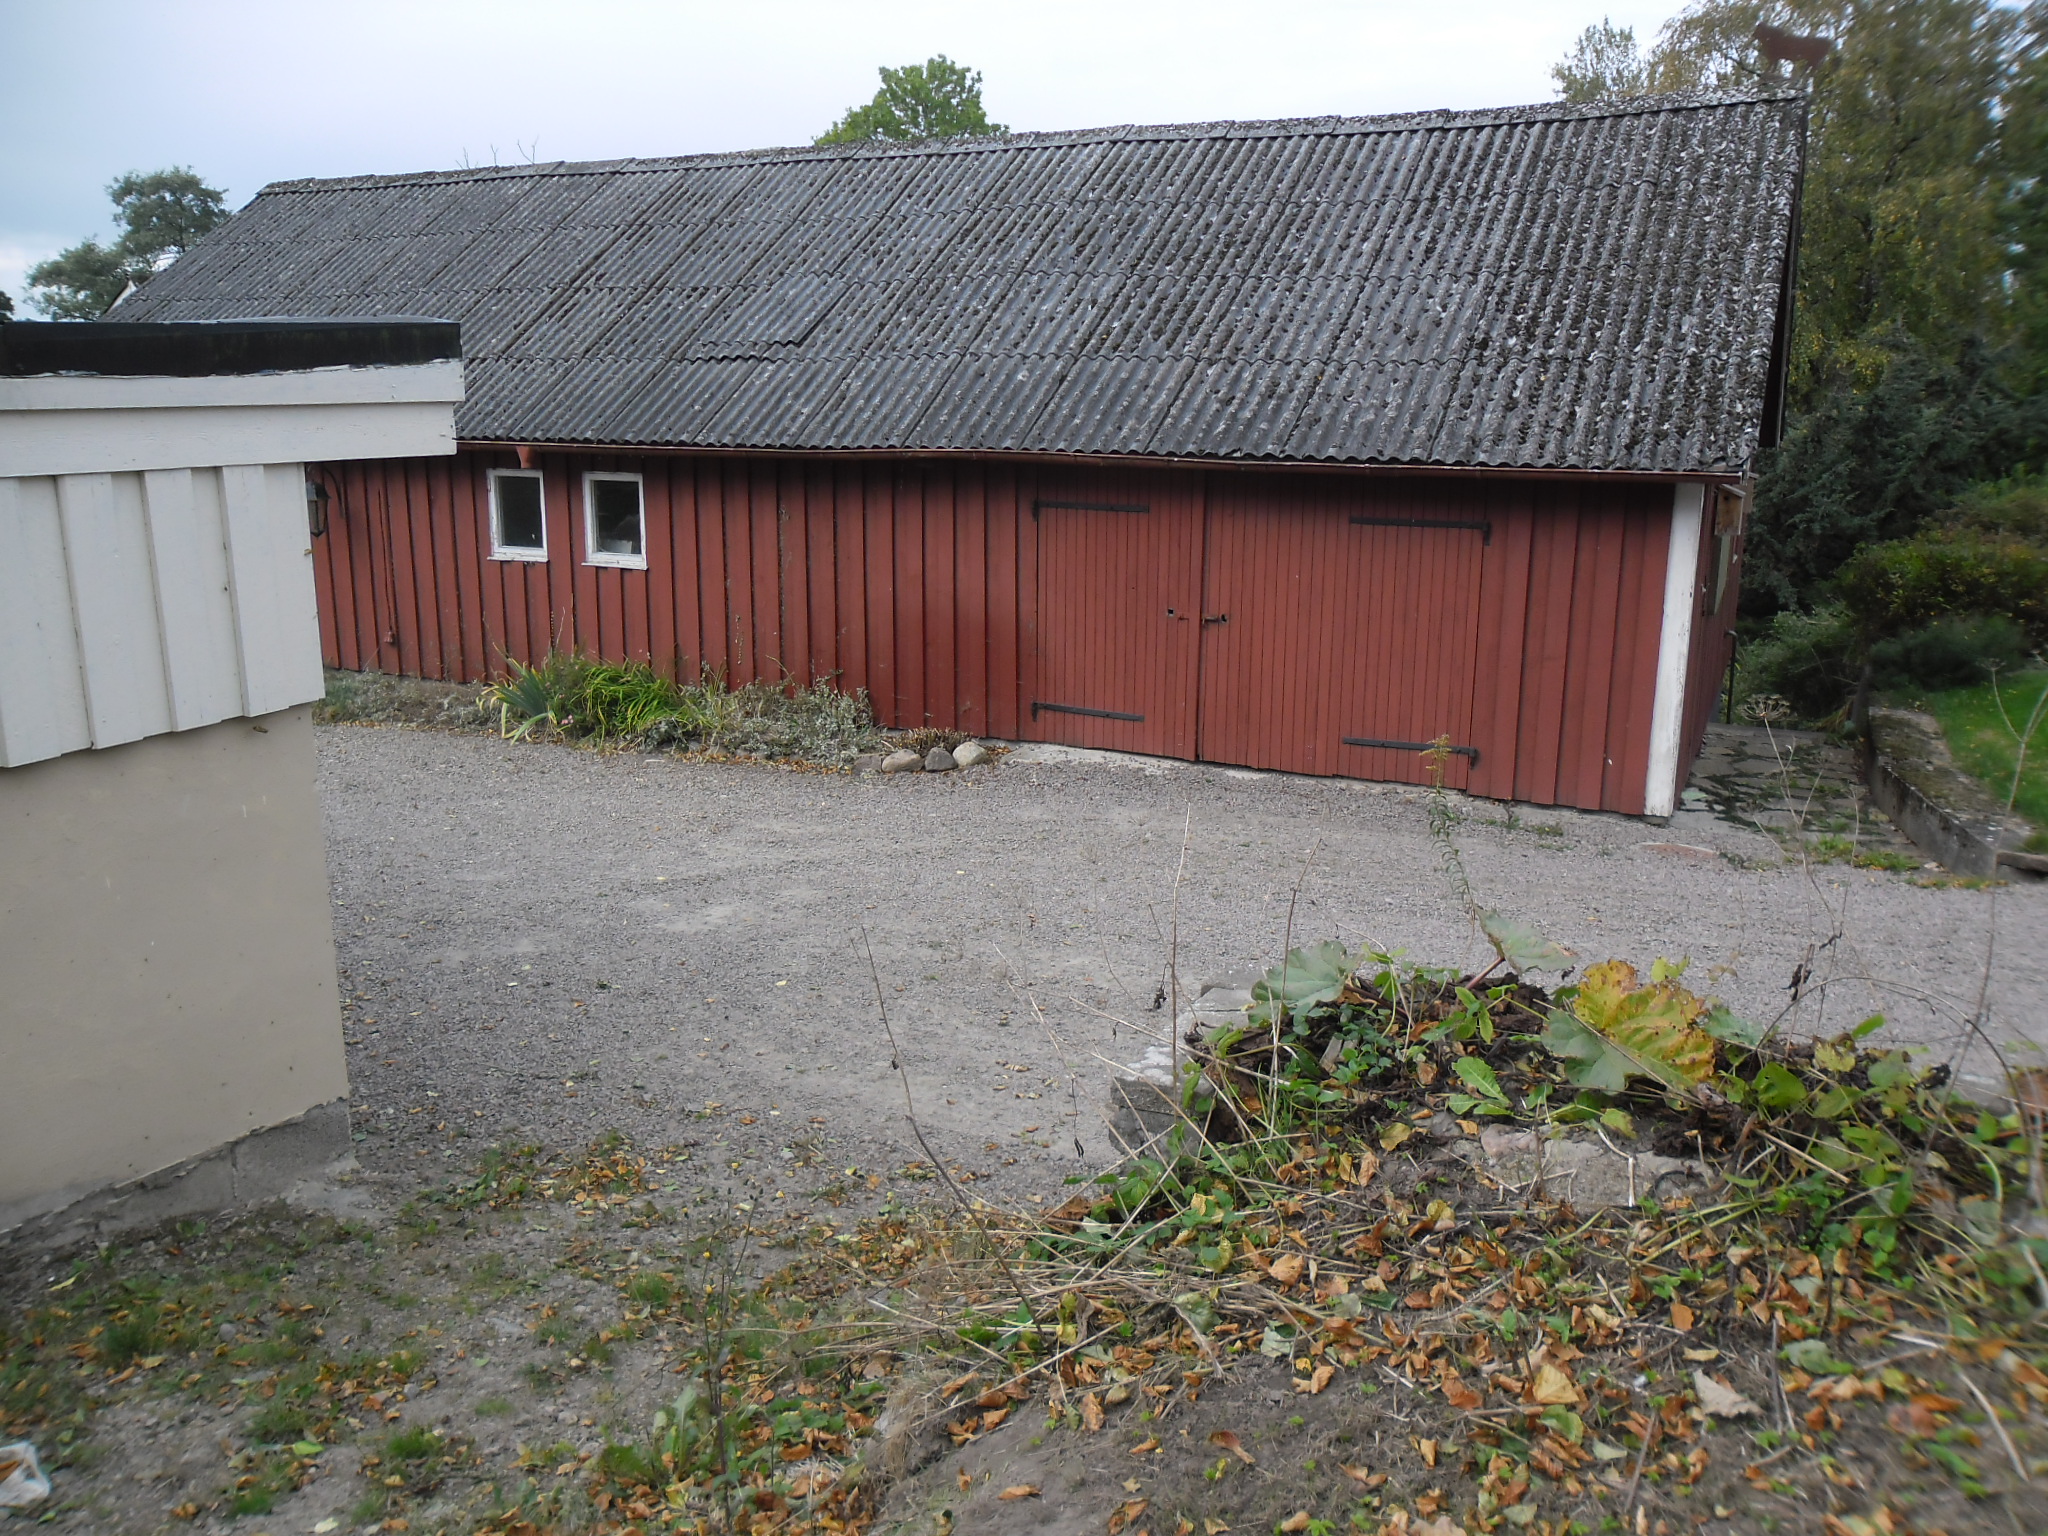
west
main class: Grassland
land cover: Grassland with sparse tree/shrub cover
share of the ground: > 75 %
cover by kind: herbaceous plants 95 %, broadleaved forest trees 5 %
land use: Residential
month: October
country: SE
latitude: 56.4914
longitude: 13.1317
